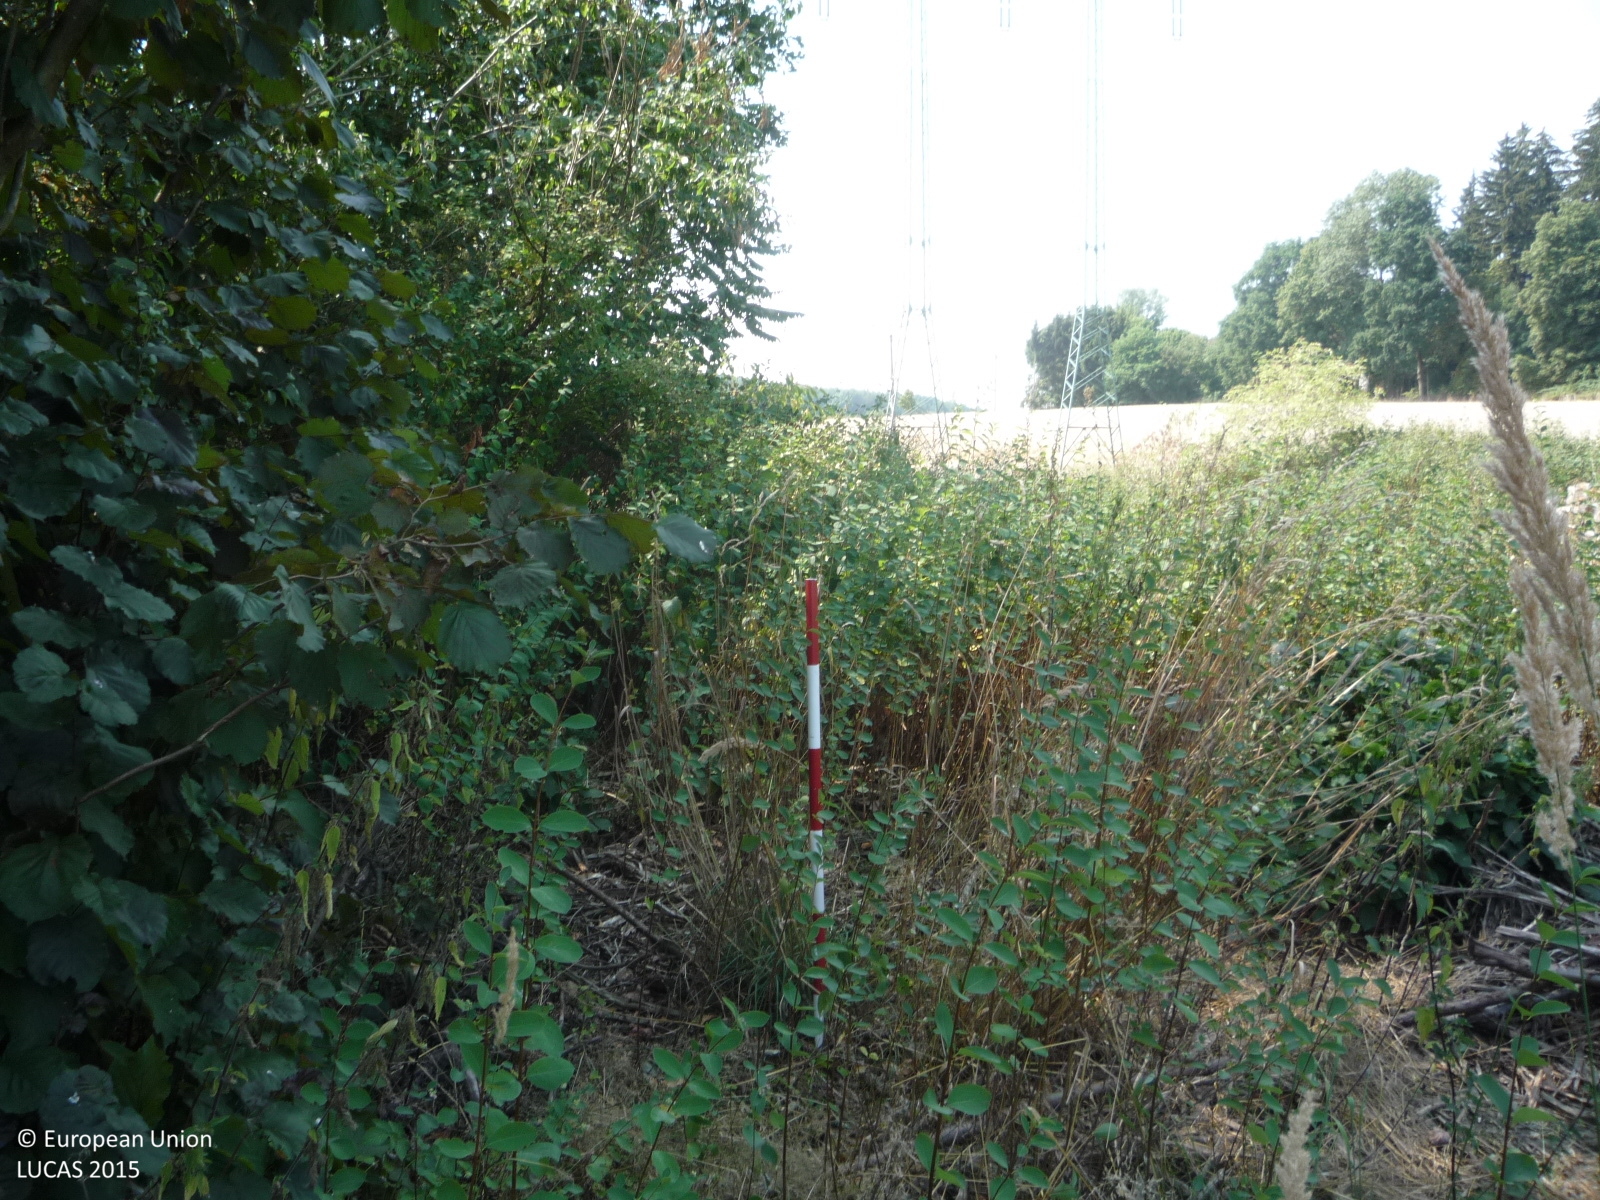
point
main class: Shrubland
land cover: Shrubland without tree cover
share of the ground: > 75 %
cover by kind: shrubs 50 %, herbaceous plants 50 %
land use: Semi-natural and natural areas not in use
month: August
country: CZ
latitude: 49.8582
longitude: 14.5782
